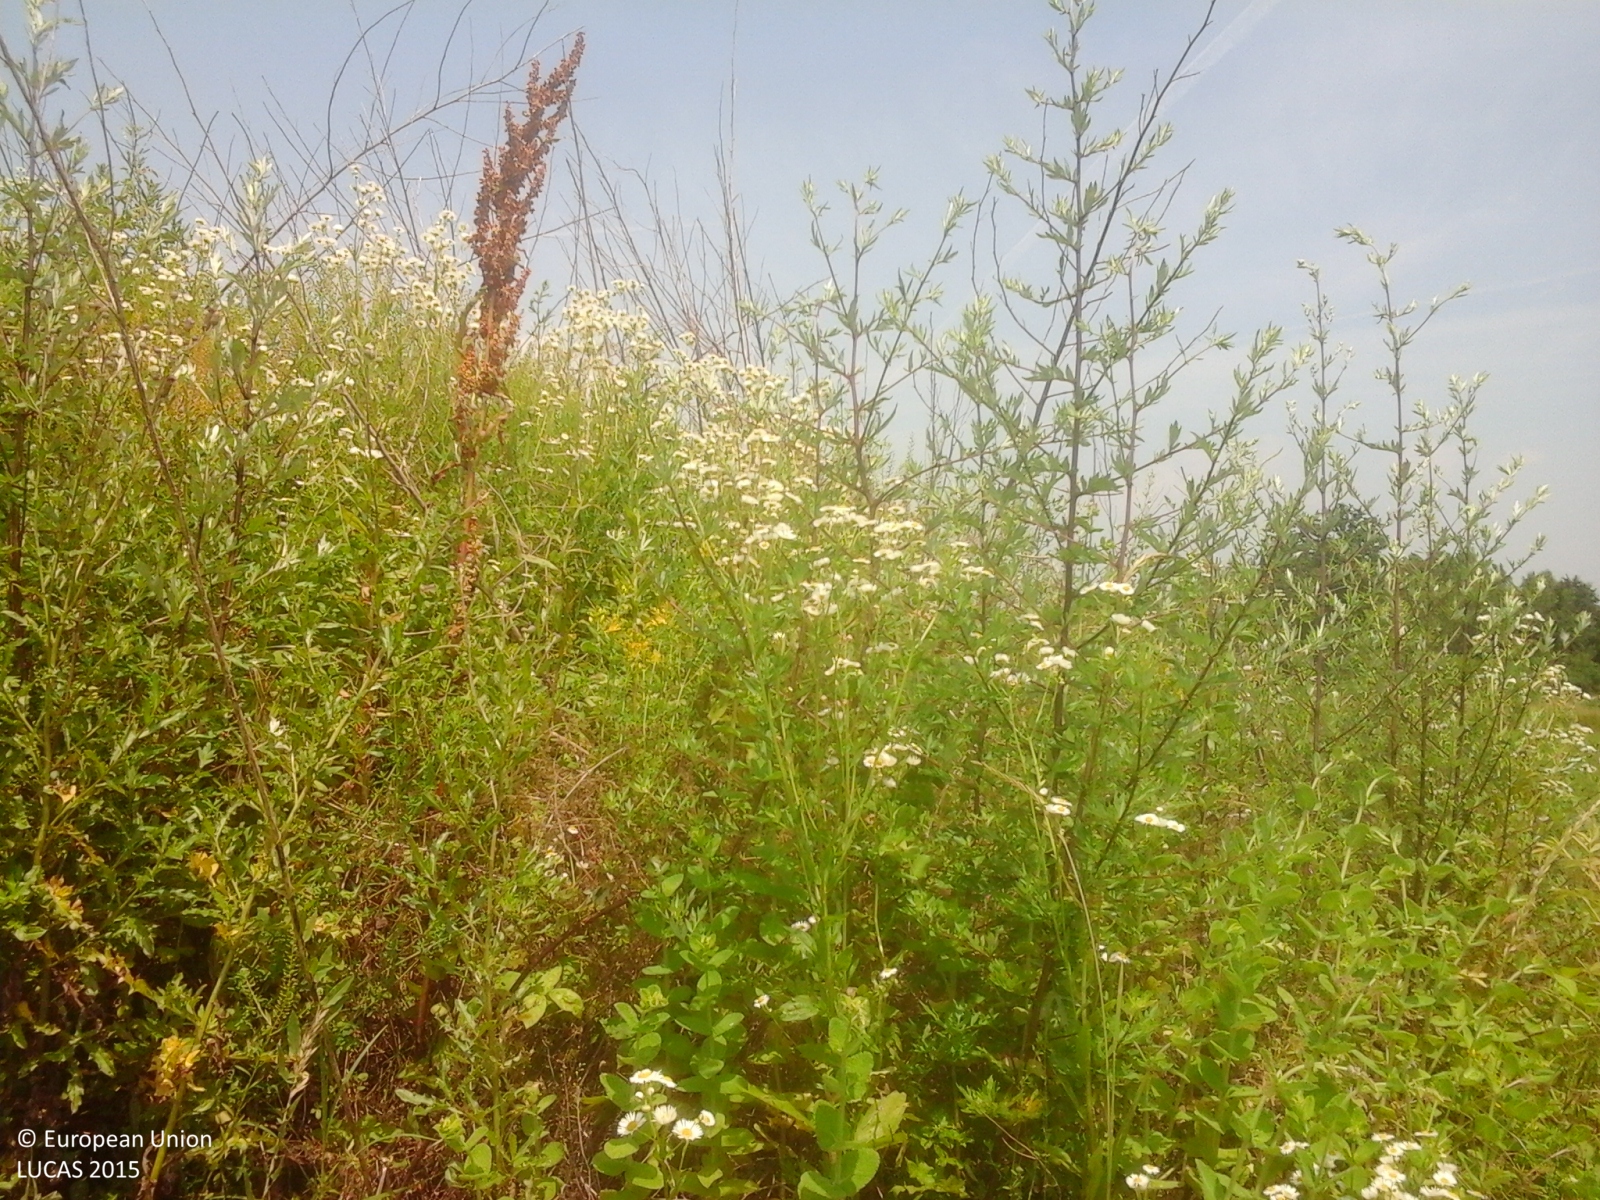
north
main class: Cropland
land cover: Rice
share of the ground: 50 - 75 %
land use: Agriculture (excluding fallow land and kitchen gardens)
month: June
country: IT
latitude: 45.4055
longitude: 8.6353
